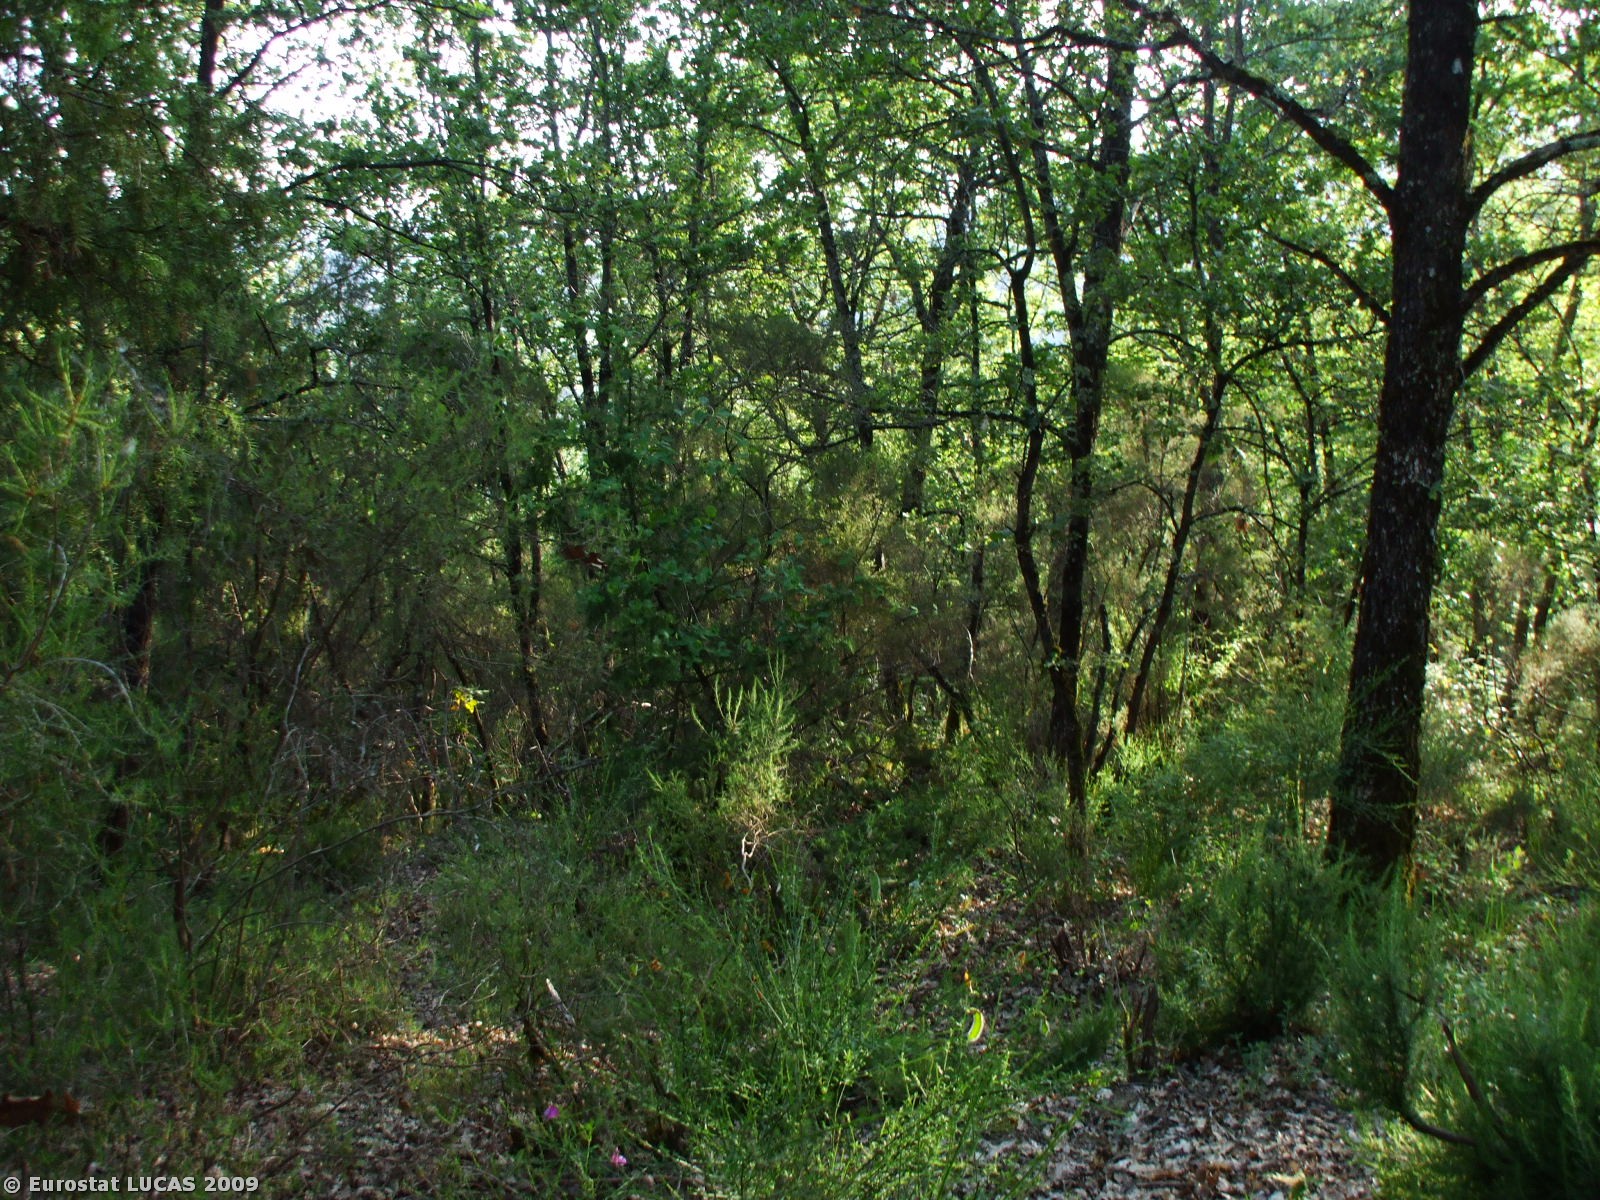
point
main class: Woodland
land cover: Broadleaved woodland
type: thermophilous deciduous forest
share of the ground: > 75 %
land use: Forestry
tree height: > 5 m
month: May
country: IT
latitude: 43.4819
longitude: 12.0592
